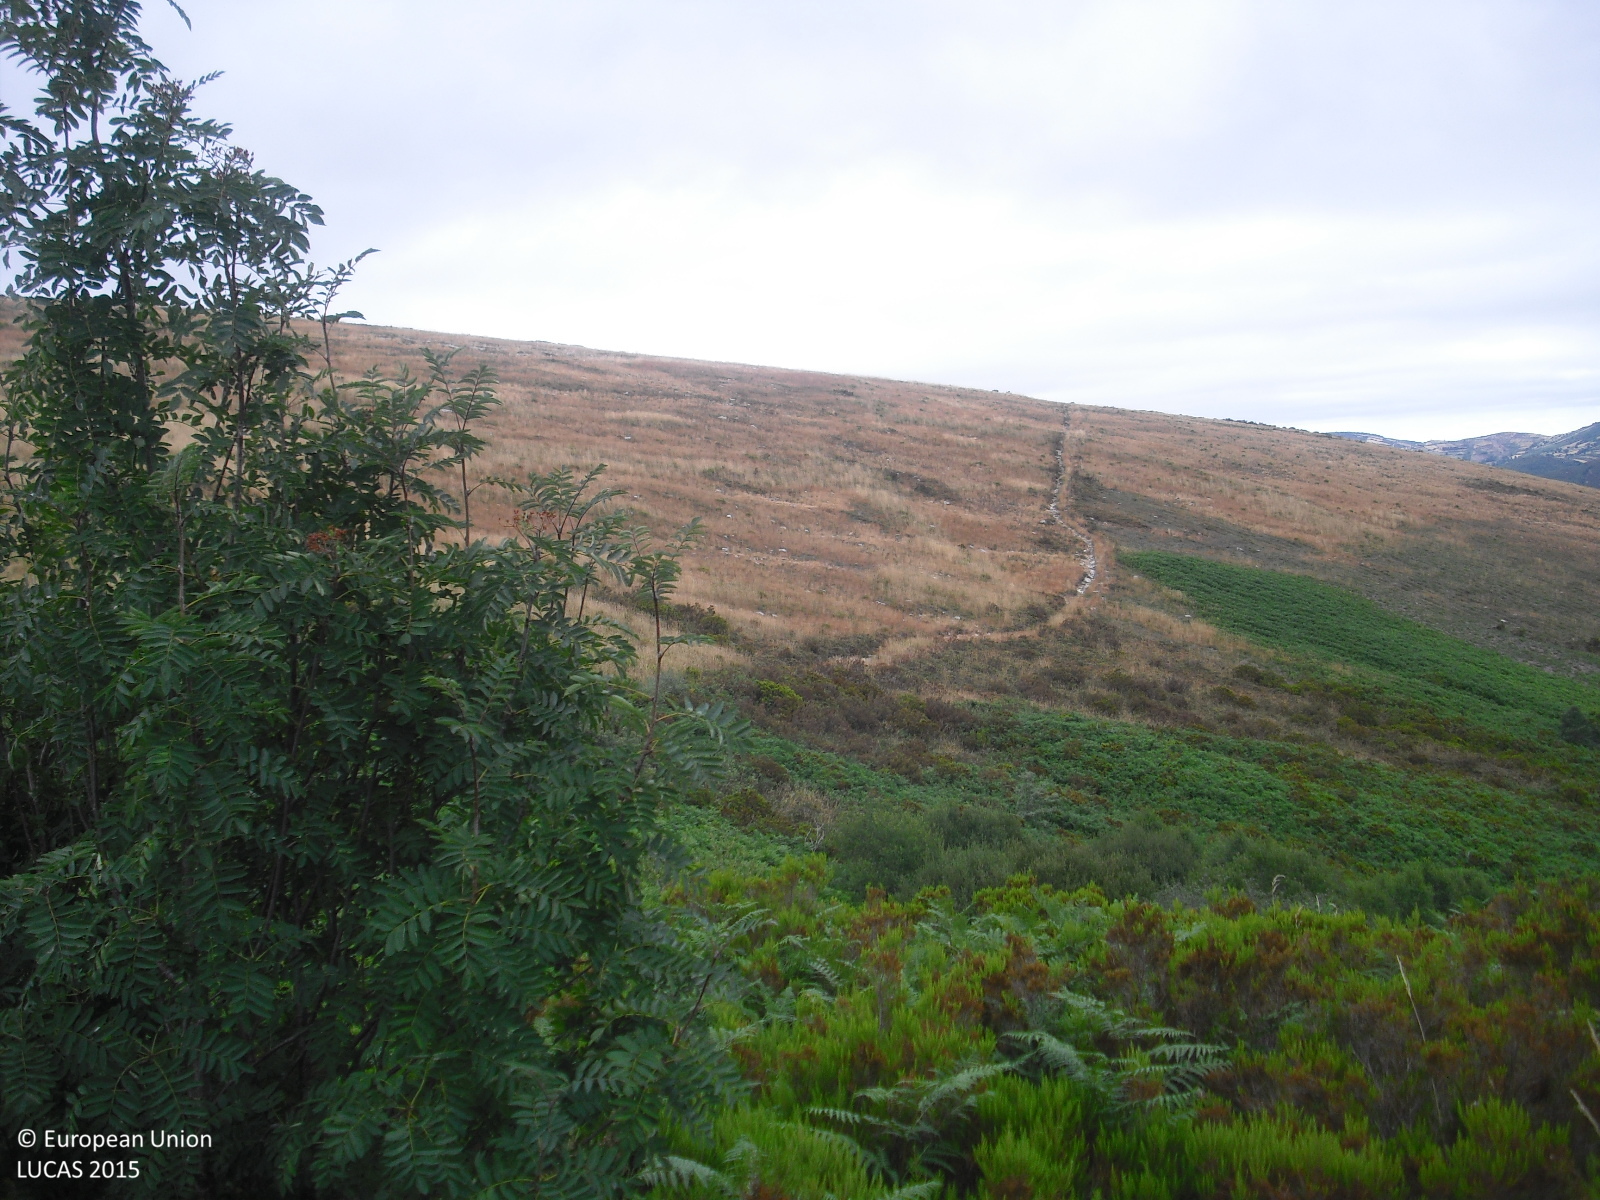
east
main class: Shrubland
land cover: Shrubland without tree cover
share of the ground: > 75 %
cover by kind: shrubs 100 %
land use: Agriculture (excluding fallow land and kitchen gardens)
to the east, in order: Shrubland without tree cover; Shrubland with sparse tree cover; Shrubland without tree cover; Tracks; Shrubland without tree cover; Rock outcrops; Shrubland without tree cover
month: July
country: ES
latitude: 42.7095
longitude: -7.2435
